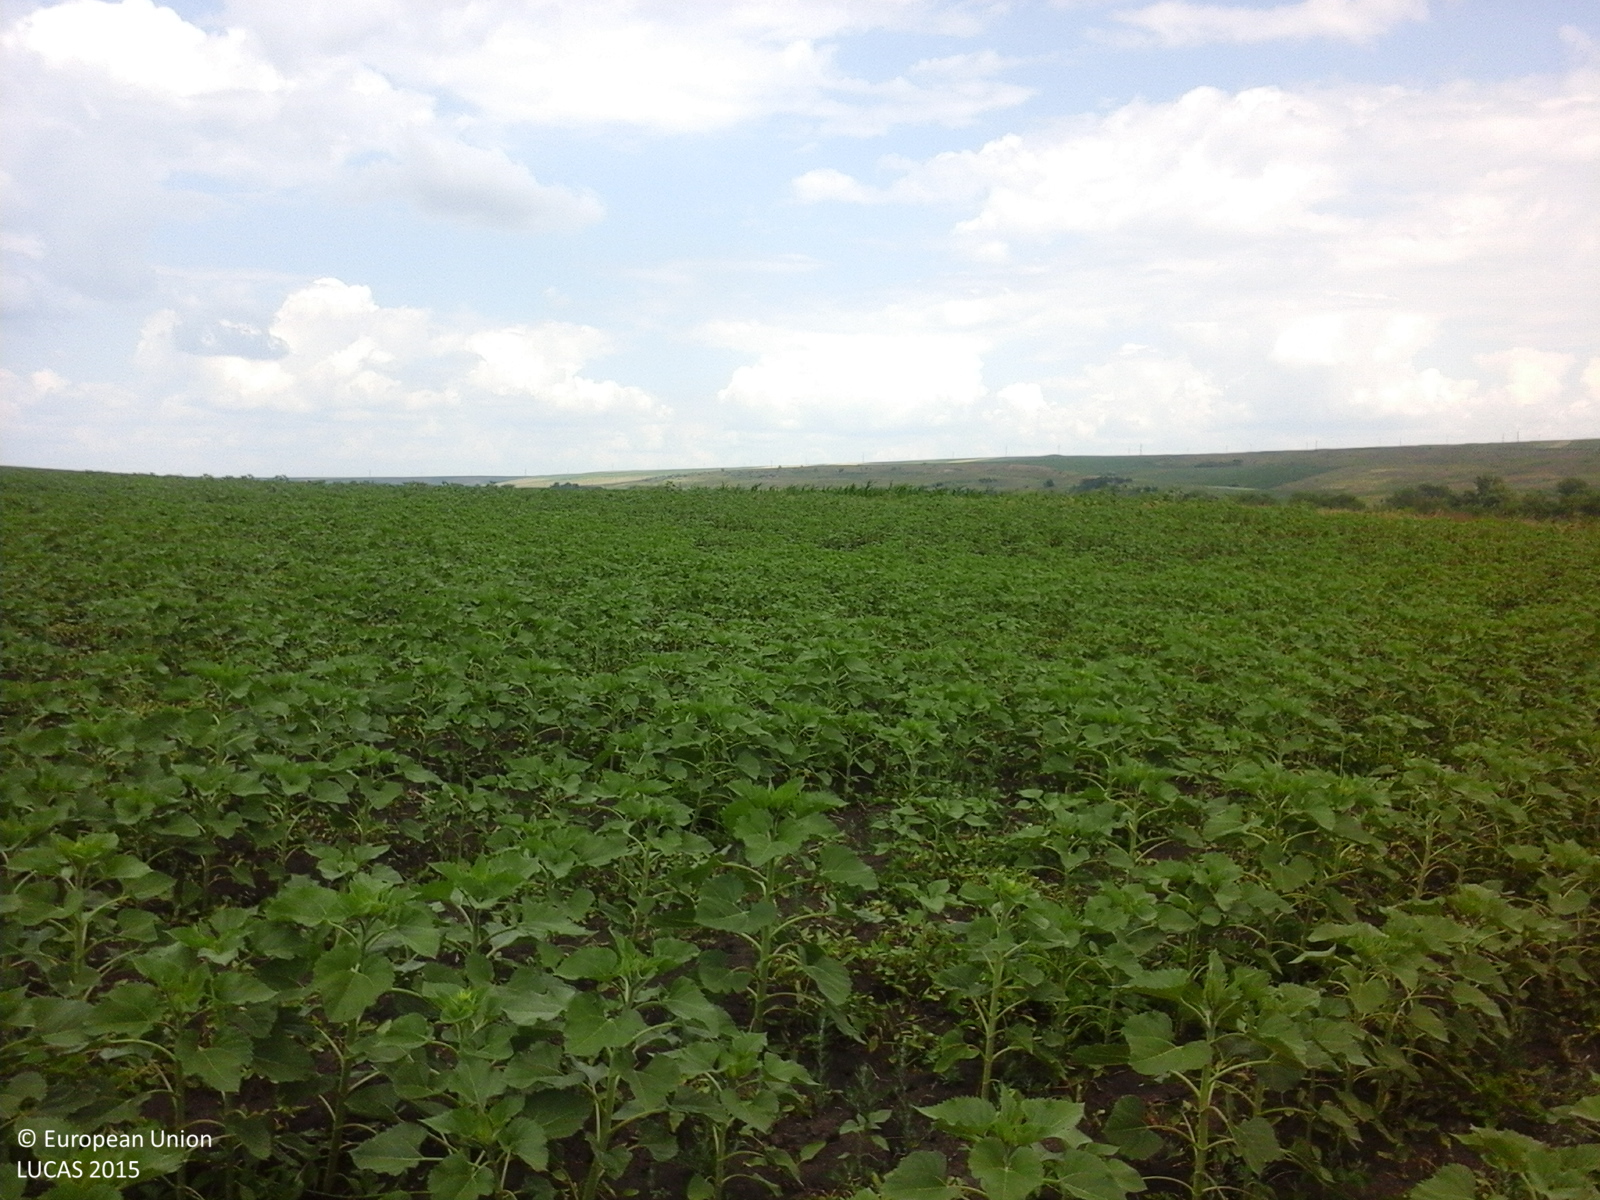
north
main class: Cropland
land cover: Sunflower
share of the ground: 25 - 50 %
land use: Agriculture (excluding fallow land and kitchen gardens)
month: June
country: RO
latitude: 48.0200
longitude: 26.7103
